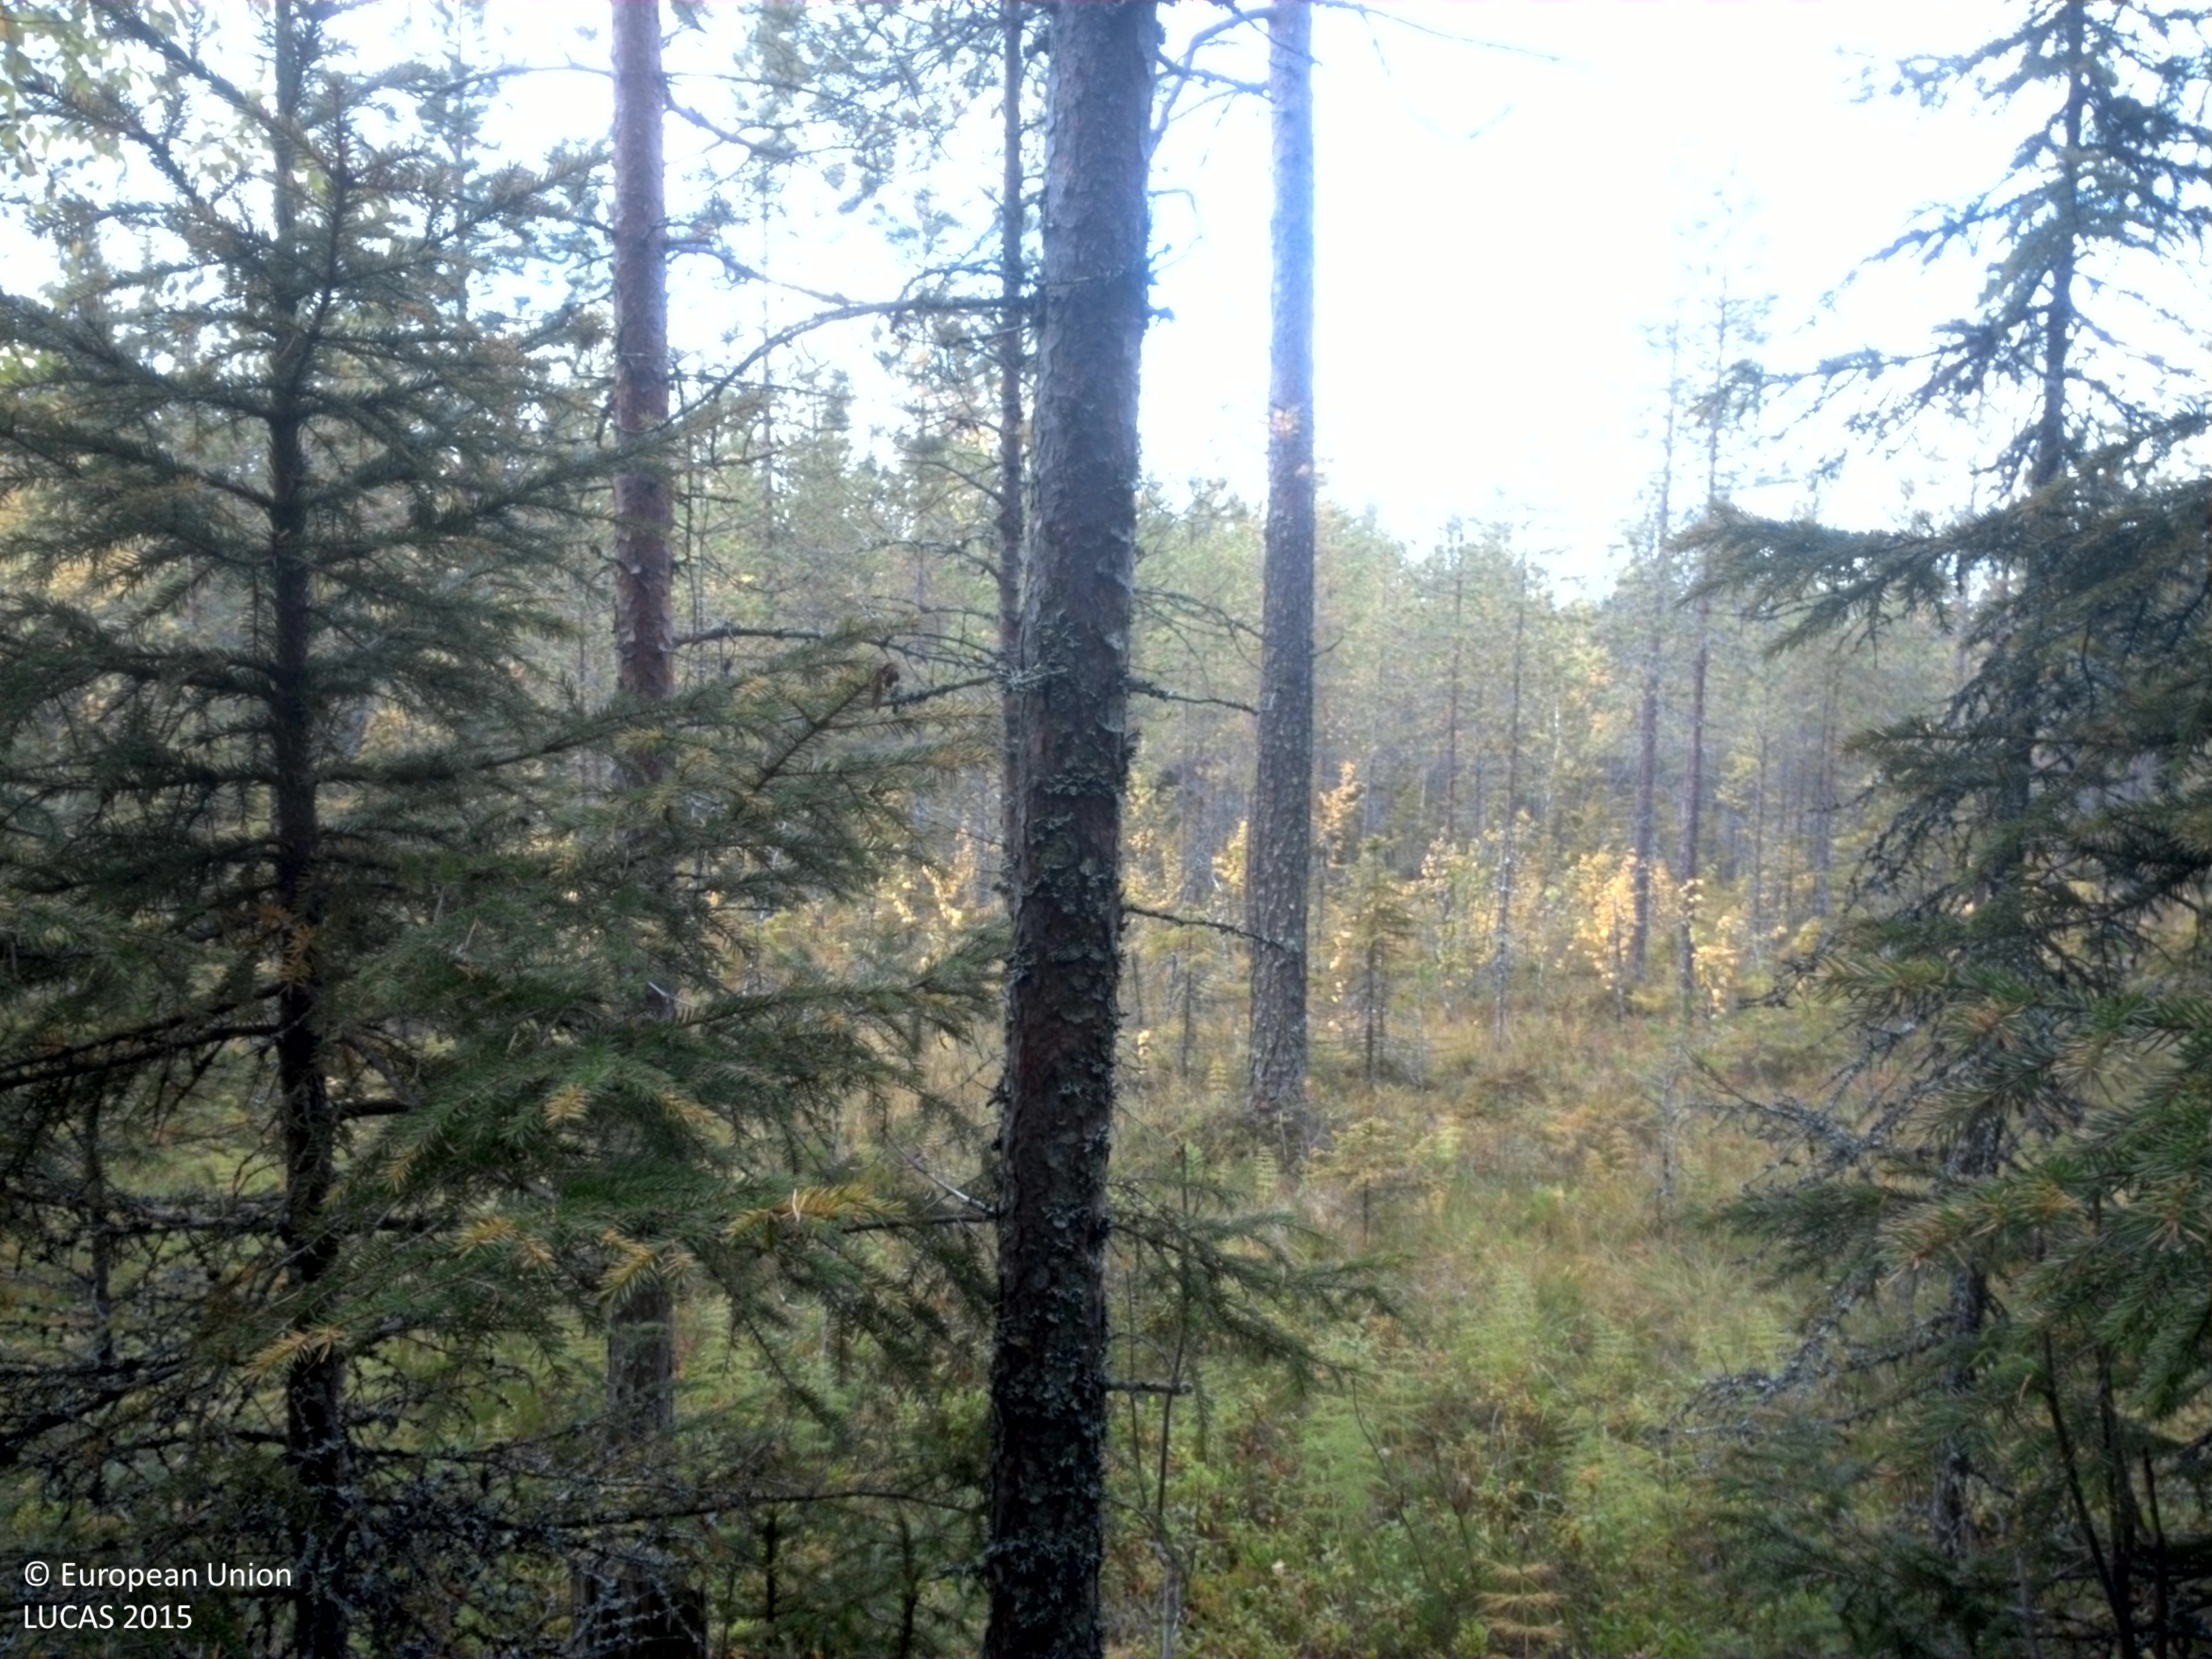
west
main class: Woodland
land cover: Spruce dominated mixed woodland
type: boreal forest
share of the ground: 50 - 75 %
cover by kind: coniferous forest trees 45 %, shrubs 35 %, broadleaved forest trees 15 %, lichens and mosses 5 %
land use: Forestry
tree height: > 5 m
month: September
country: SE
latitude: 64.4790
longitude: 19.7710
